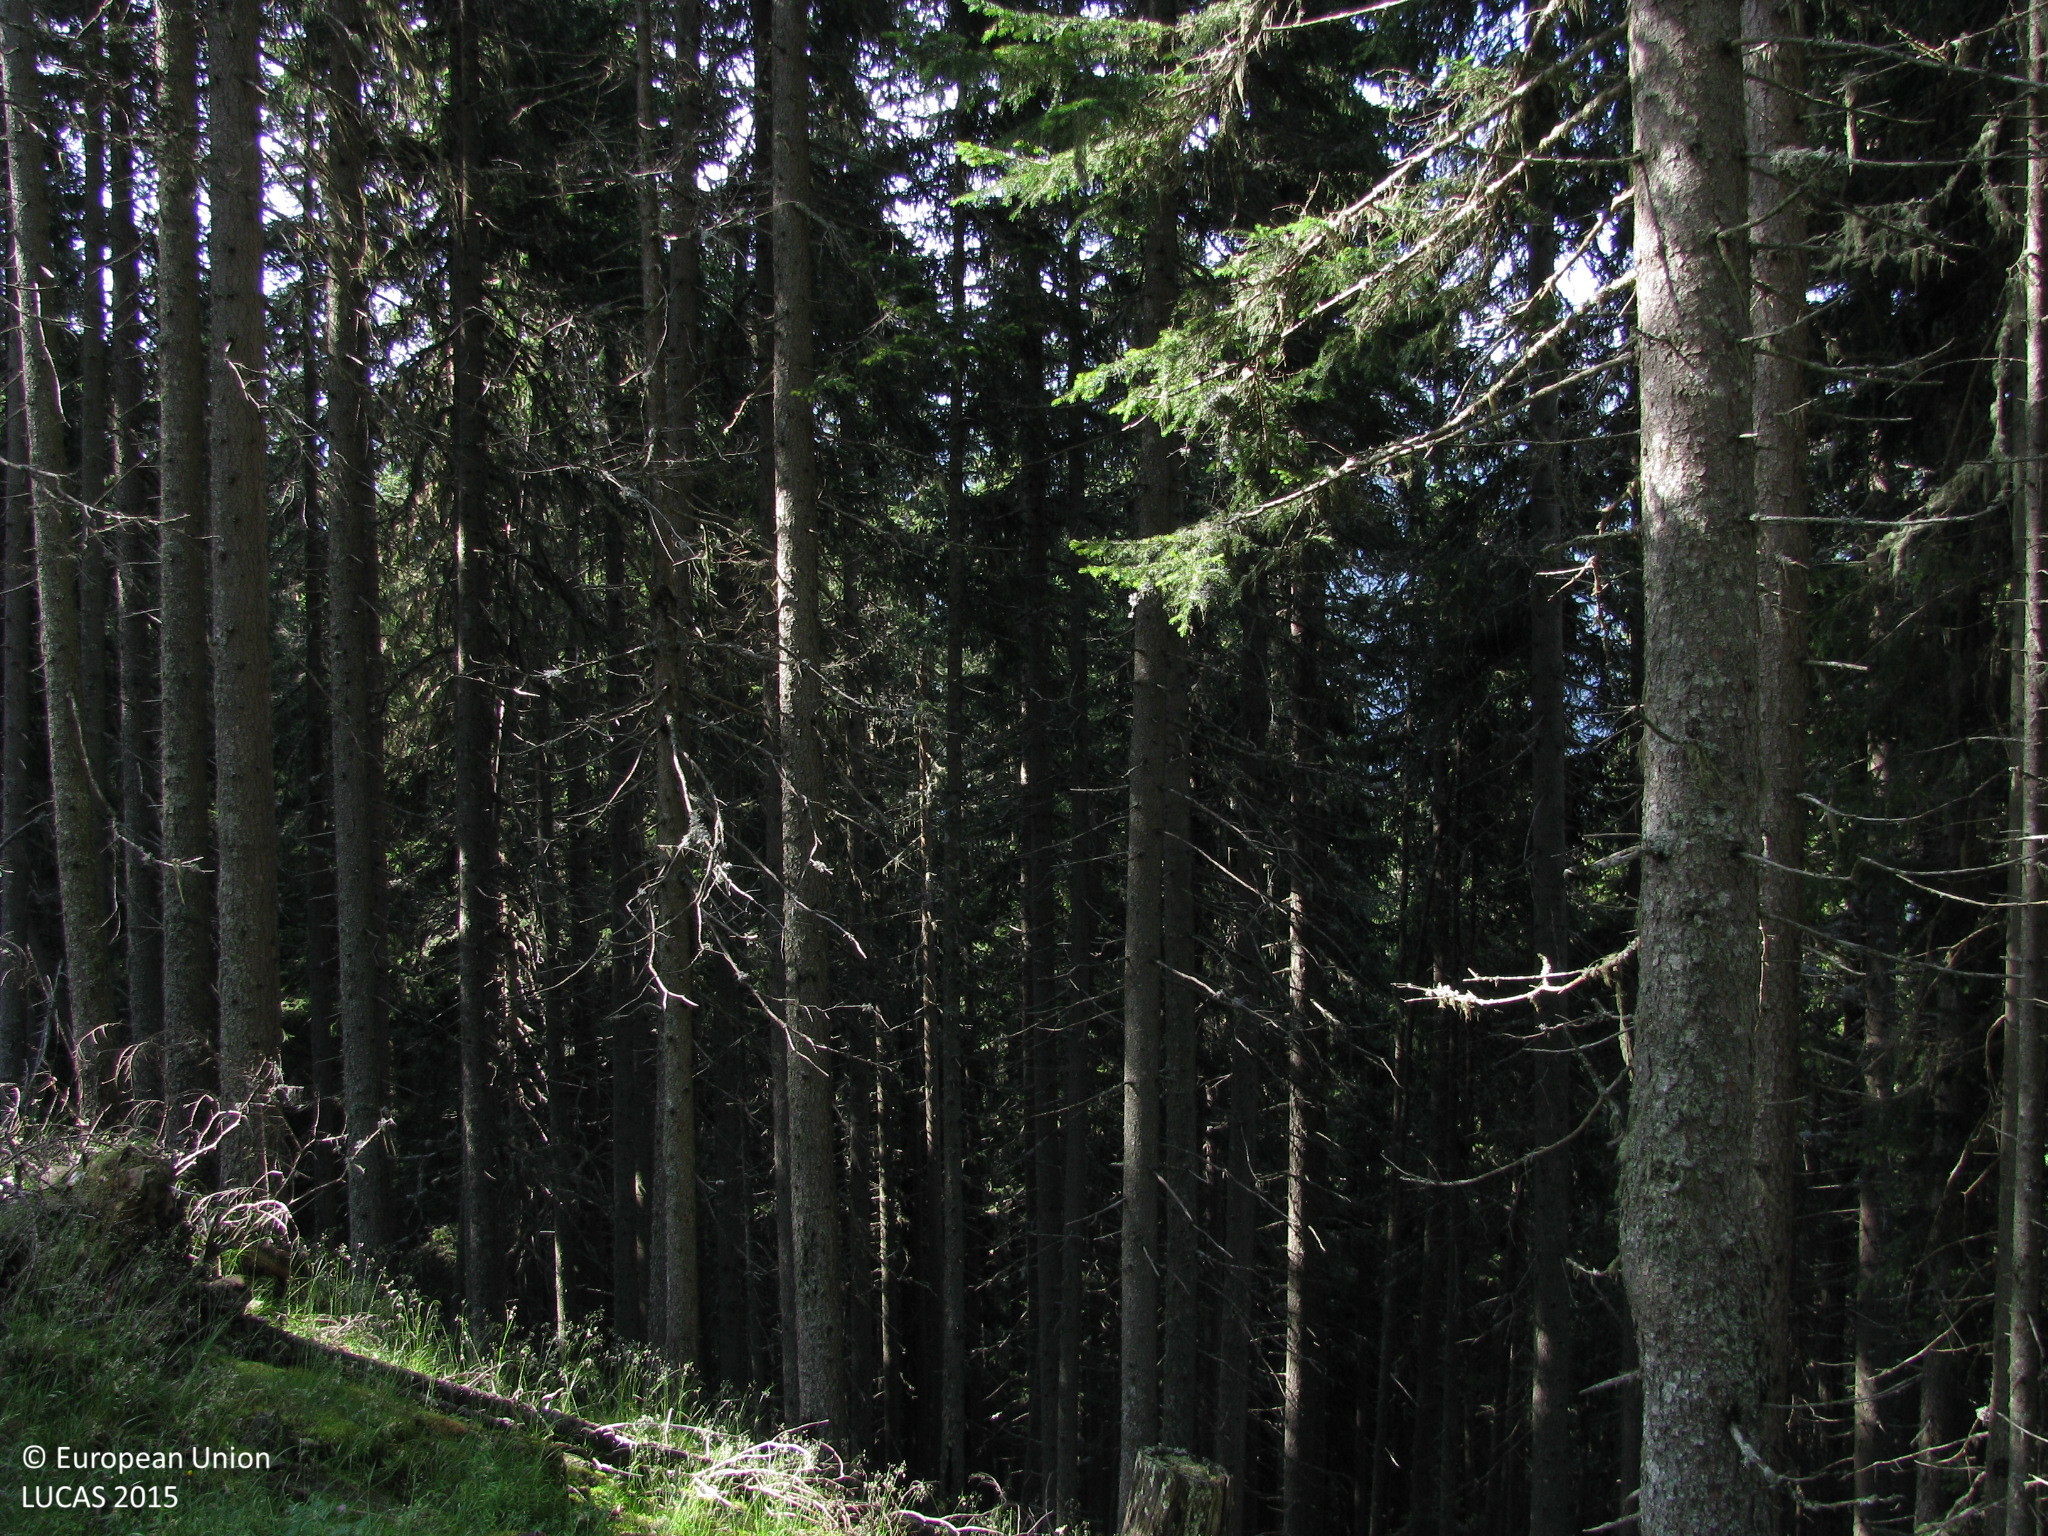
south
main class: Woodland
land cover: Spruce dominated coniferous woodland
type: alpine coniferous forest
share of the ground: > 75 %
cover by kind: coniferous forest trees 80 %, herbaceous plants 10 %, shrubs 5 %, lichens and mosses 5 %
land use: Forestry
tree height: > 5 m
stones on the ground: 25 - 50 %
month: July
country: AT
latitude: 46.8300
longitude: 12.3444
